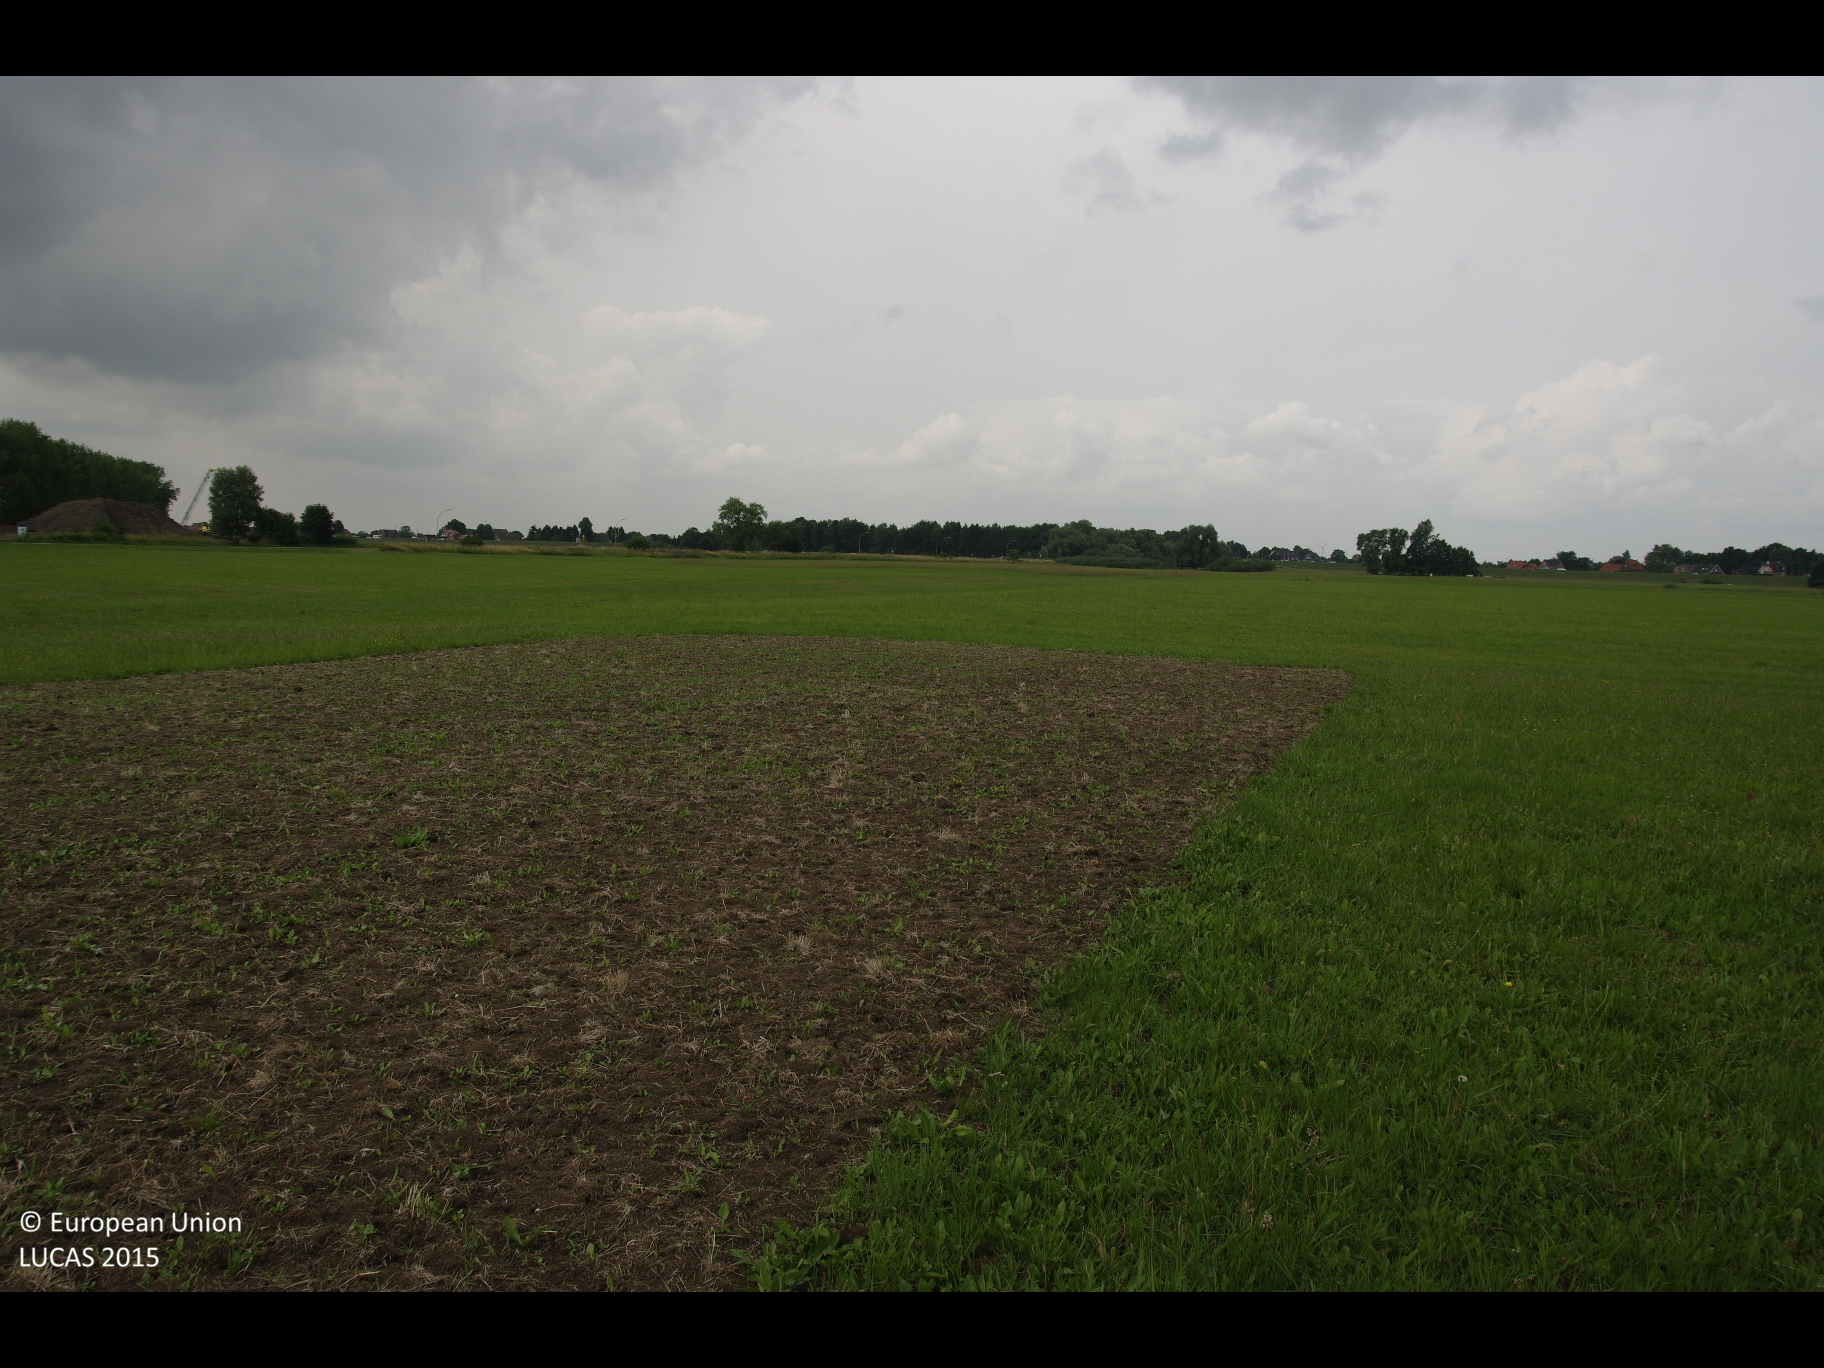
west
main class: Grassland
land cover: Grassland without tree/shrub cover
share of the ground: > 75 %
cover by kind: herbaceous plants 100 %
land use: Agriculture (excluding fallow land and kitchen gardens)
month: July
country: DE
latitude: 53.4374
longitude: 10.3160
